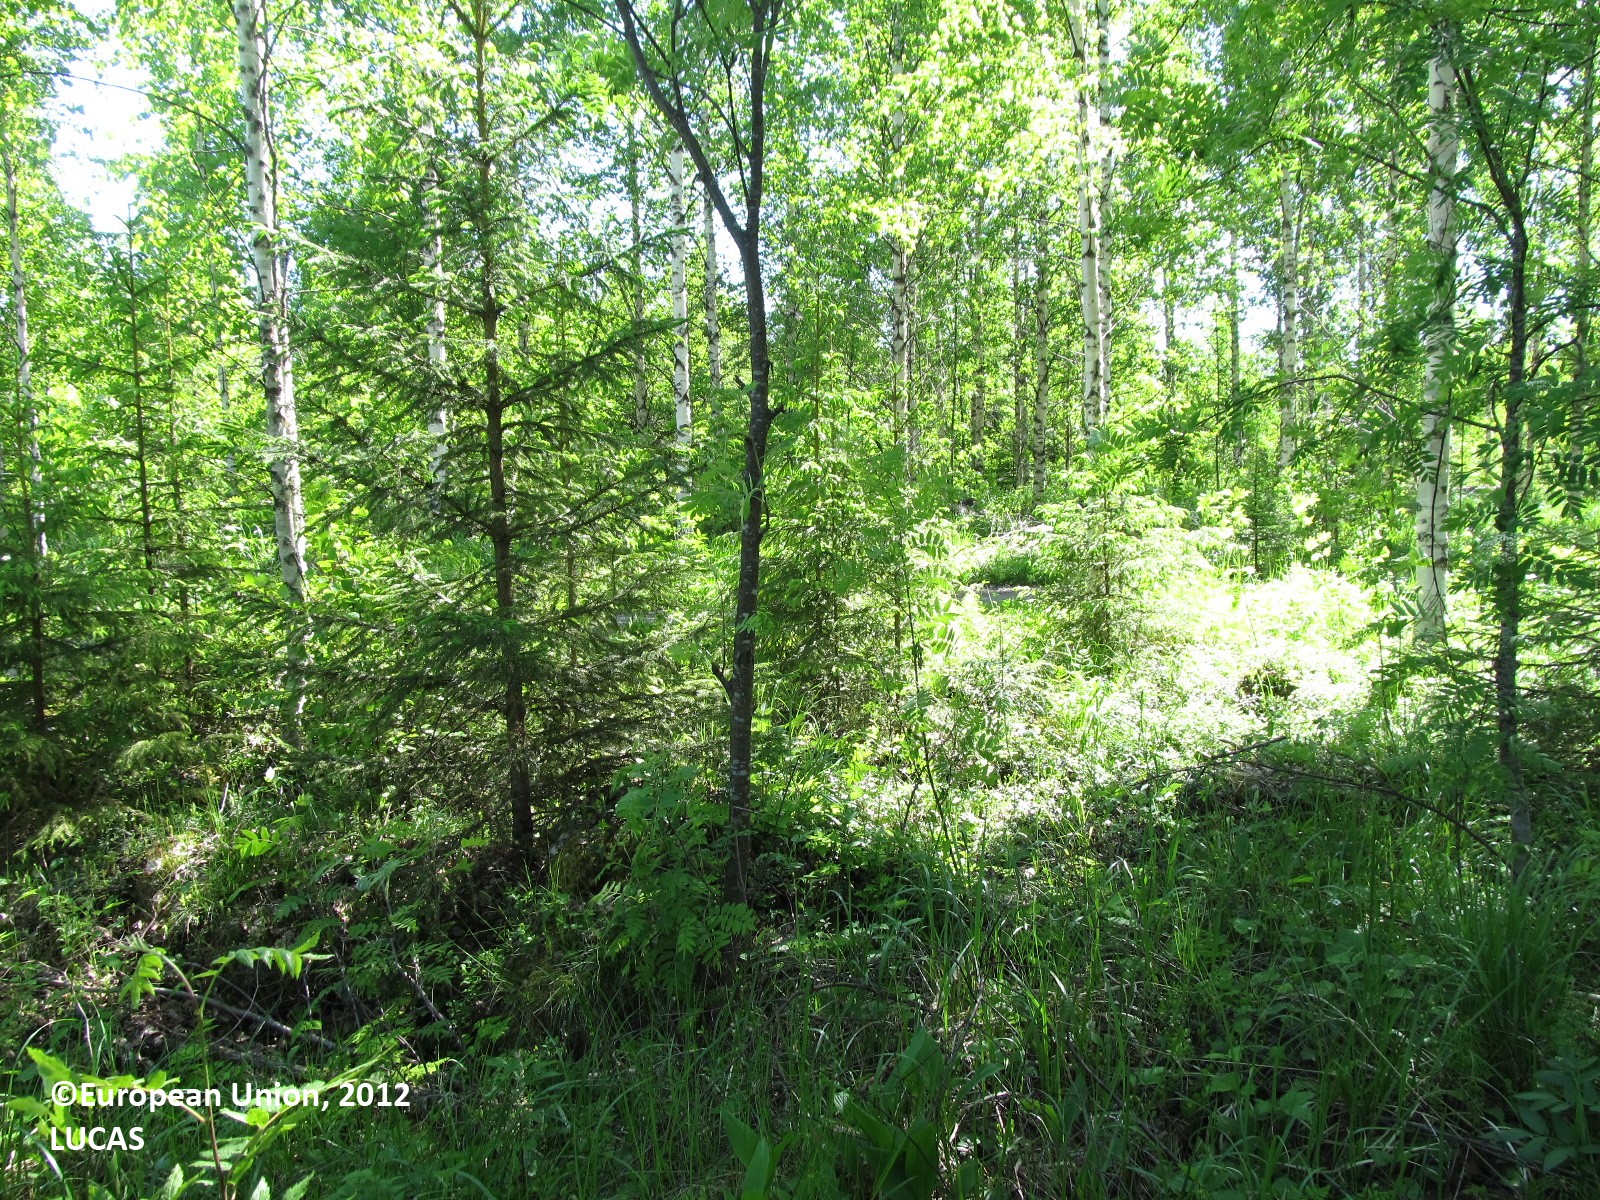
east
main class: Woodland
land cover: Broadleaved woodland
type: boreal forest
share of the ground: 50 - 75 %
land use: Forestry
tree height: > 5 m
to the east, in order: Broadleaved woodland; Paved roads, cycling and walking lanes; Broadleaved woodland; Electric lines; Other bare soil; Rocks and stones; Lichens and moss; Other bare soil; Rocks and stones; Spruce dominated mixed woodland; Rocks and stones; Electric lines; Lichens and moss; Broadleaved woodland; Other bare soil; Spruce dominated coniferous woodland; Grassland with sparse tree/shrub cover; Broadleaved woodland
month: June
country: FI
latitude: 62.6761
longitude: 27.4457
